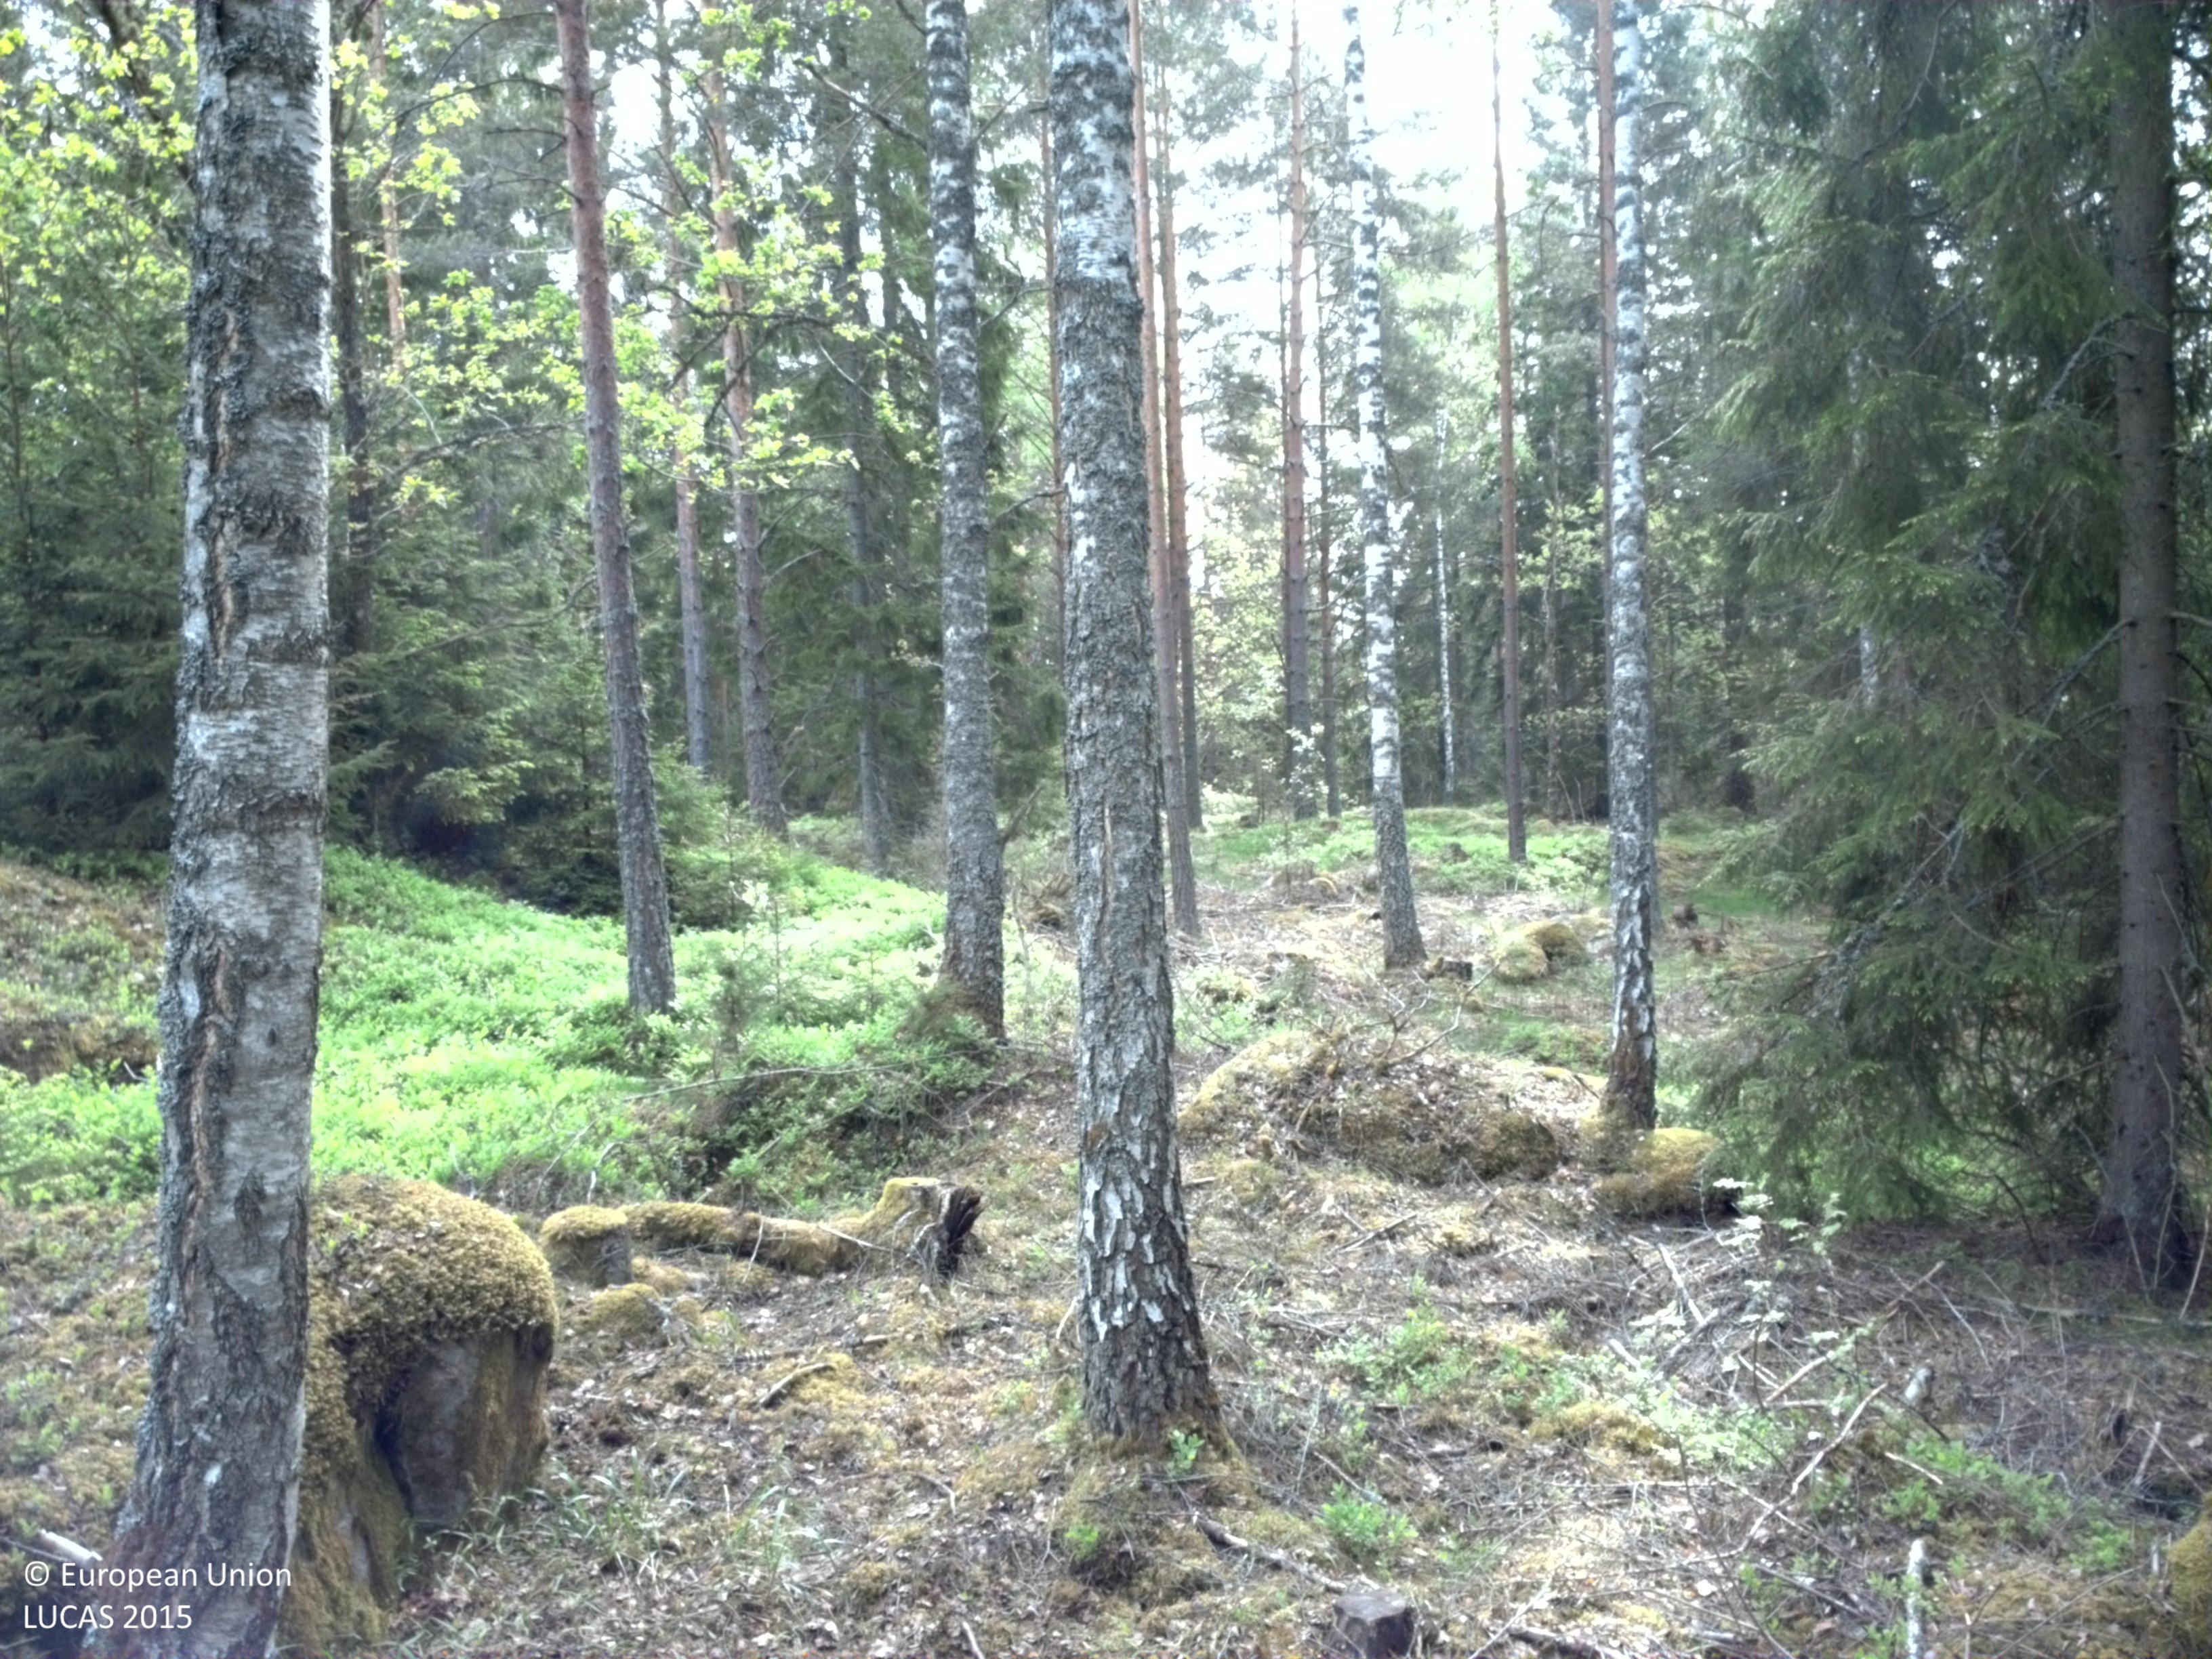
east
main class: Woodland
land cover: Pine dominated mixed woodland
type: boreal forest
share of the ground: 25 - 50 %
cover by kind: coniferous forest trees 25 %, broadleaved forest trees 25 %, shrubs 25 %, lichens and mosses 20 %, herbaceous plants 5 %
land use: Forestry
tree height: > 5 m
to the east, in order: Pine dominated mixed woodland; Pine dominated coniferous woodland; Pine dominated mixed woodland; Spruce dominated mixed woodland; Spruce dominated coniferous woodland; Tracks; Spruce dominated coniferous woodland
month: May
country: SE
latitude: 57.3456
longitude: 15.5973
